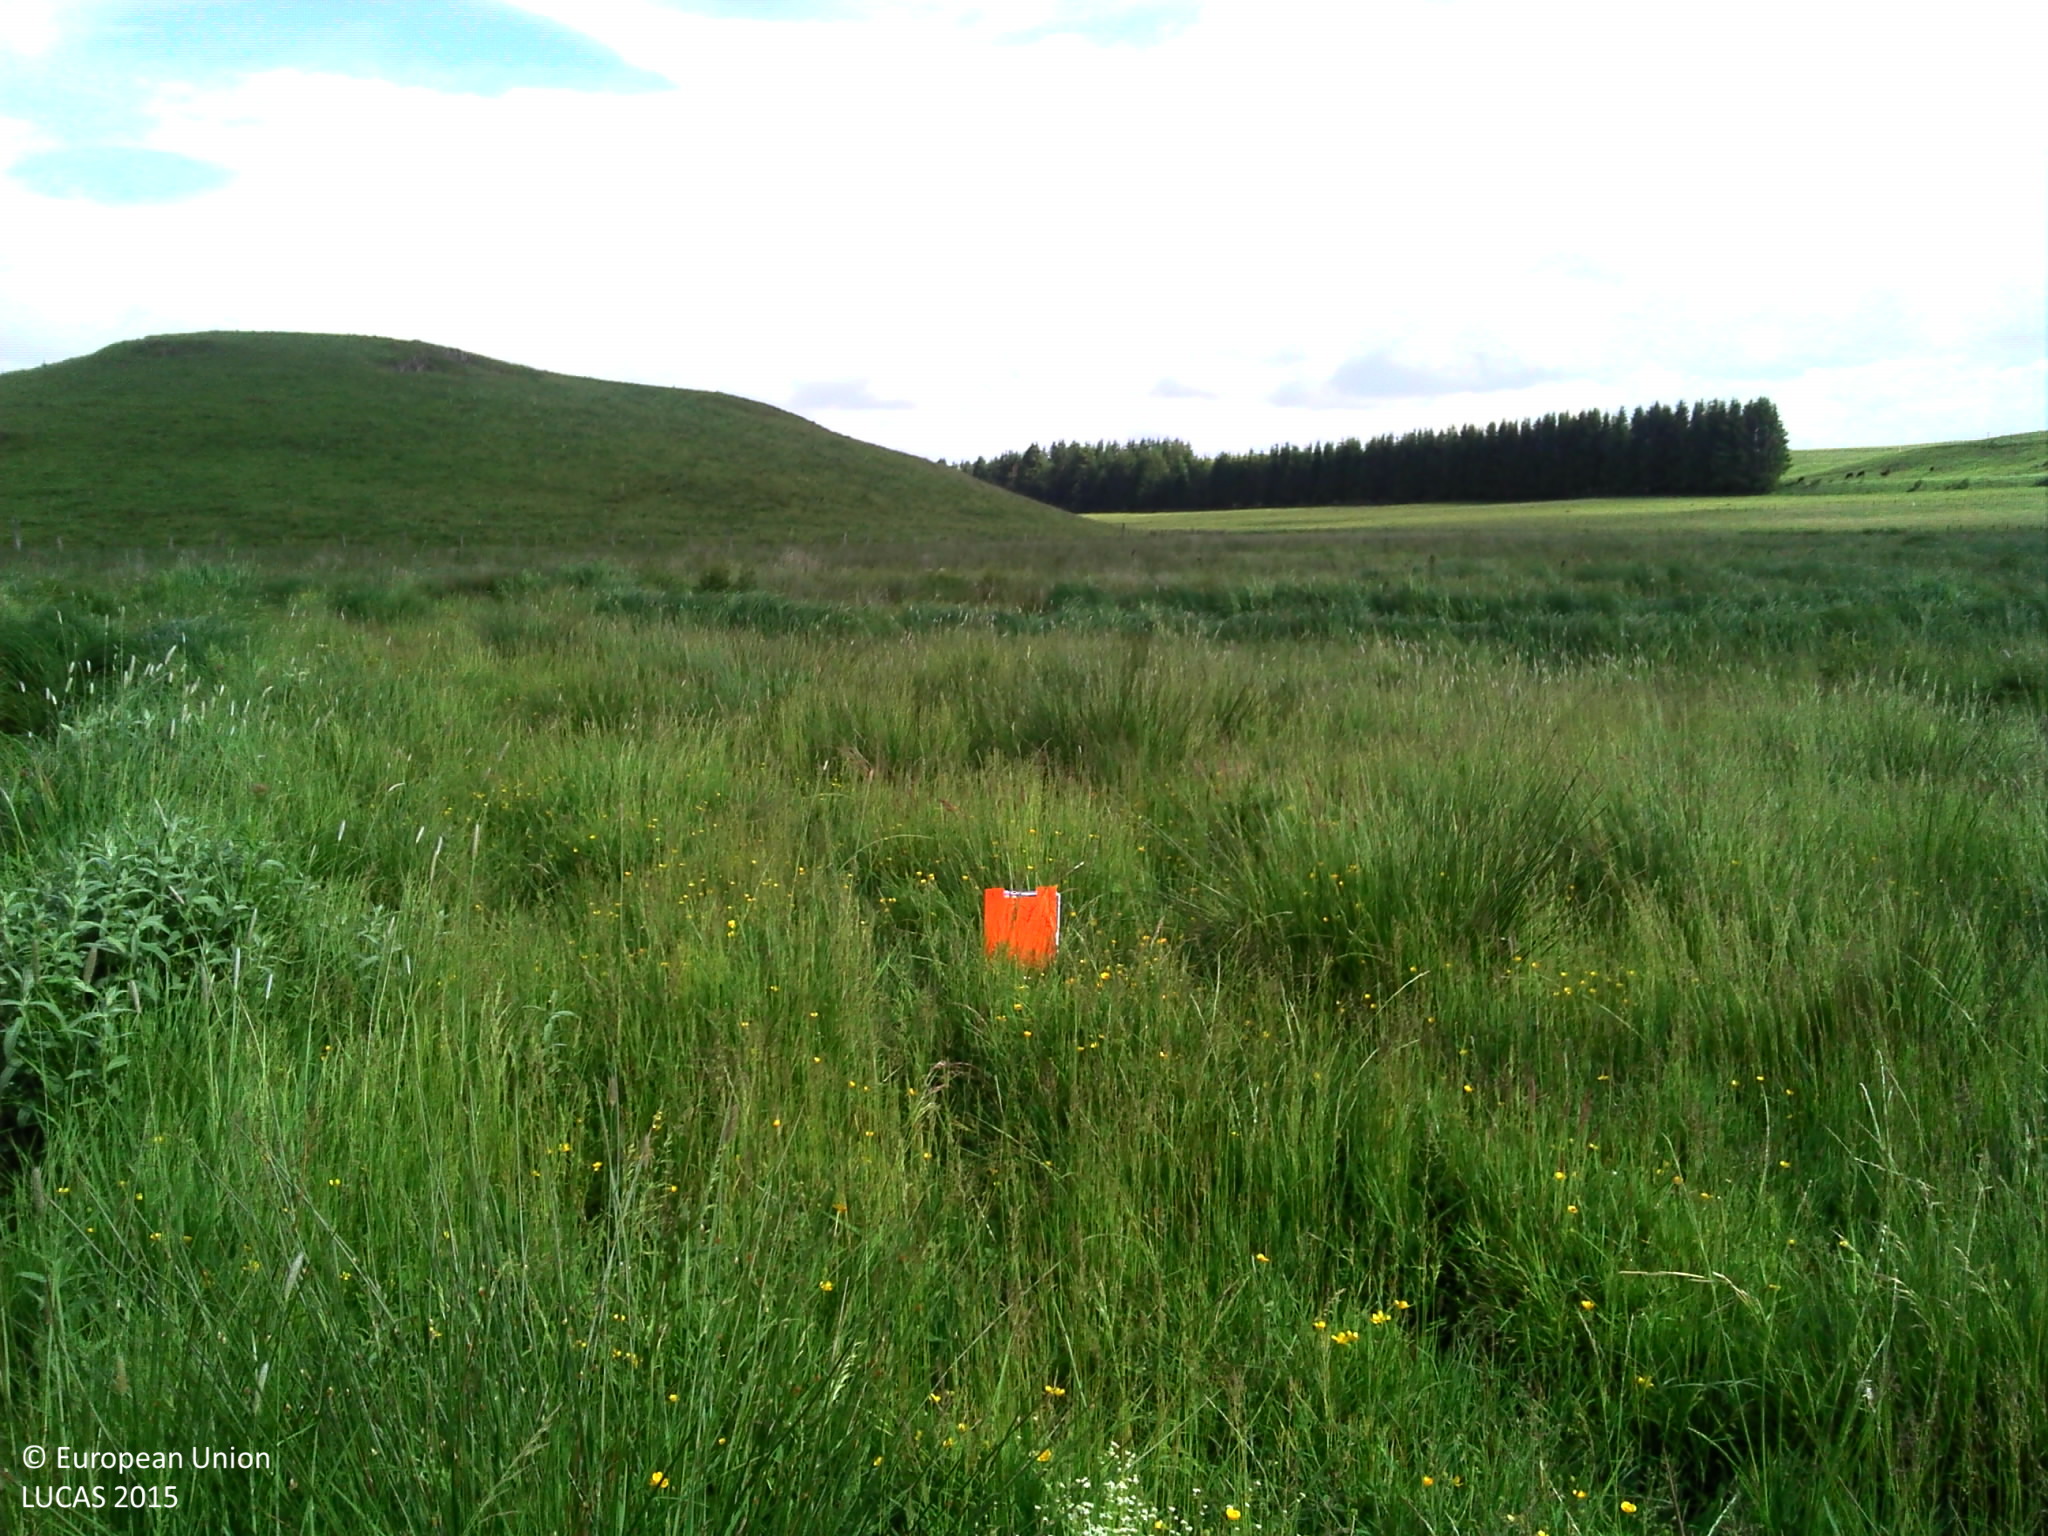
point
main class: Grassland
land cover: Grassland without tree/shrub cover
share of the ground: > 75 %
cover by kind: herbaceous plants 100 %
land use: Agriculture (excluding fallow land and kitchen gardens)
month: June
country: FR
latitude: 45.2636
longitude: 2.8766
